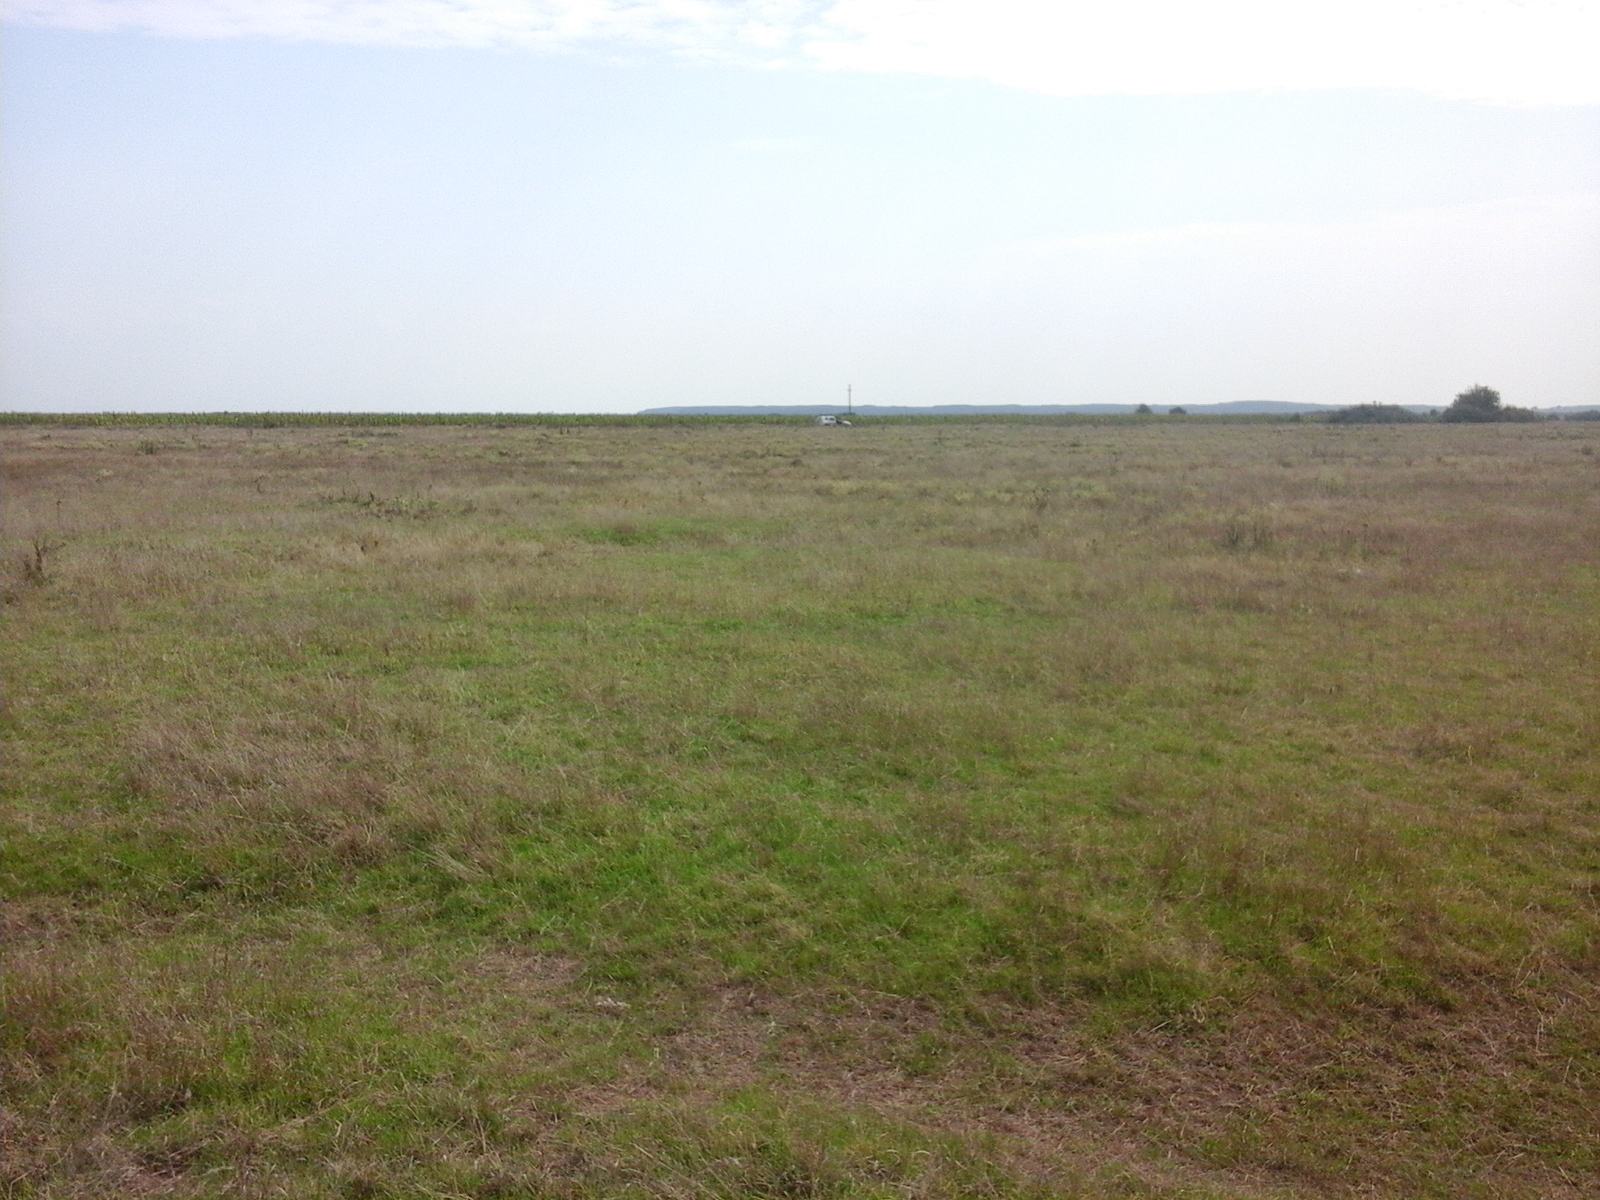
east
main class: Grassland
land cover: Spontaneously vegetated surfaces
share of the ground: > 75 %
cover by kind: herbaceous plants 100 %
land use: Fallow land
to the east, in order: Spontaneously vegetated surfaces; Ditches and canals; Grass margins; Tracks; Grass margins; Maize
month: August
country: RO
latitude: 46.6067
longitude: 21.6204
